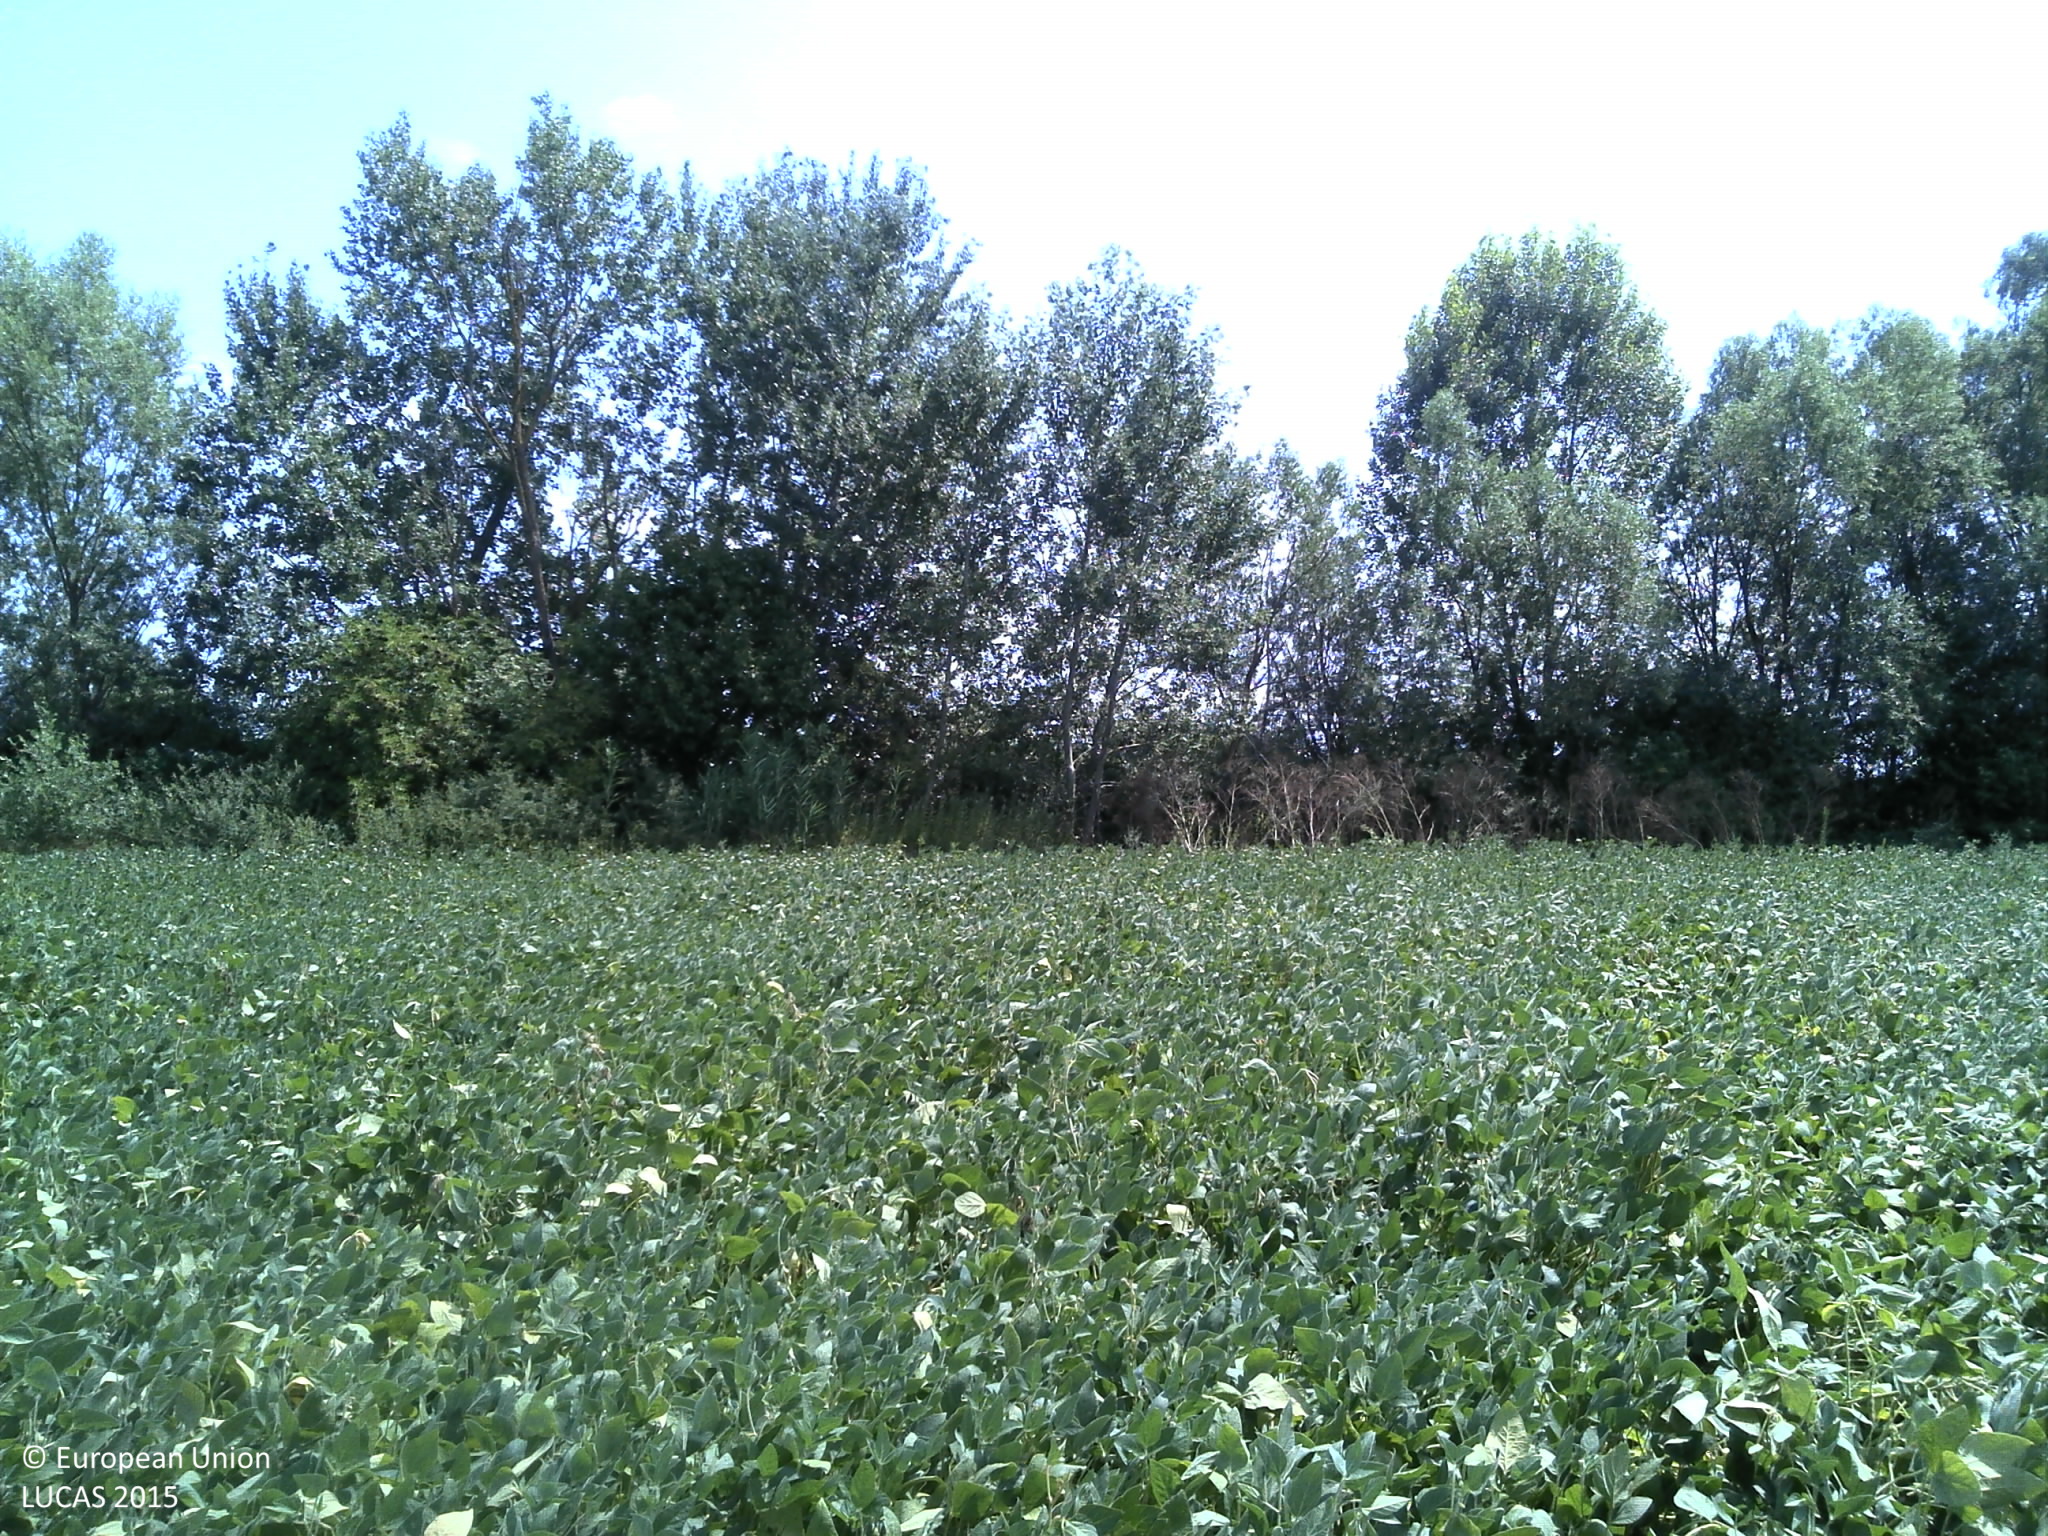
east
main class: Cropland
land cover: Soya
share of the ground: > 75 %
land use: Agriculture (excluding fallow land and kitchen gardens)
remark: Tilled/Sowed
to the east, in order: Soya; Shrubland with sparse tree cover; Ditches and canals; Shrubland with sparse tree cover; Soya; Common wheat; Shrubland with sparse tree cover; Ditches and canals; Shrubland with sparse tree cover; Maize
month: July
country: HR
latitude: 44.9052
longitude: 18.9605
